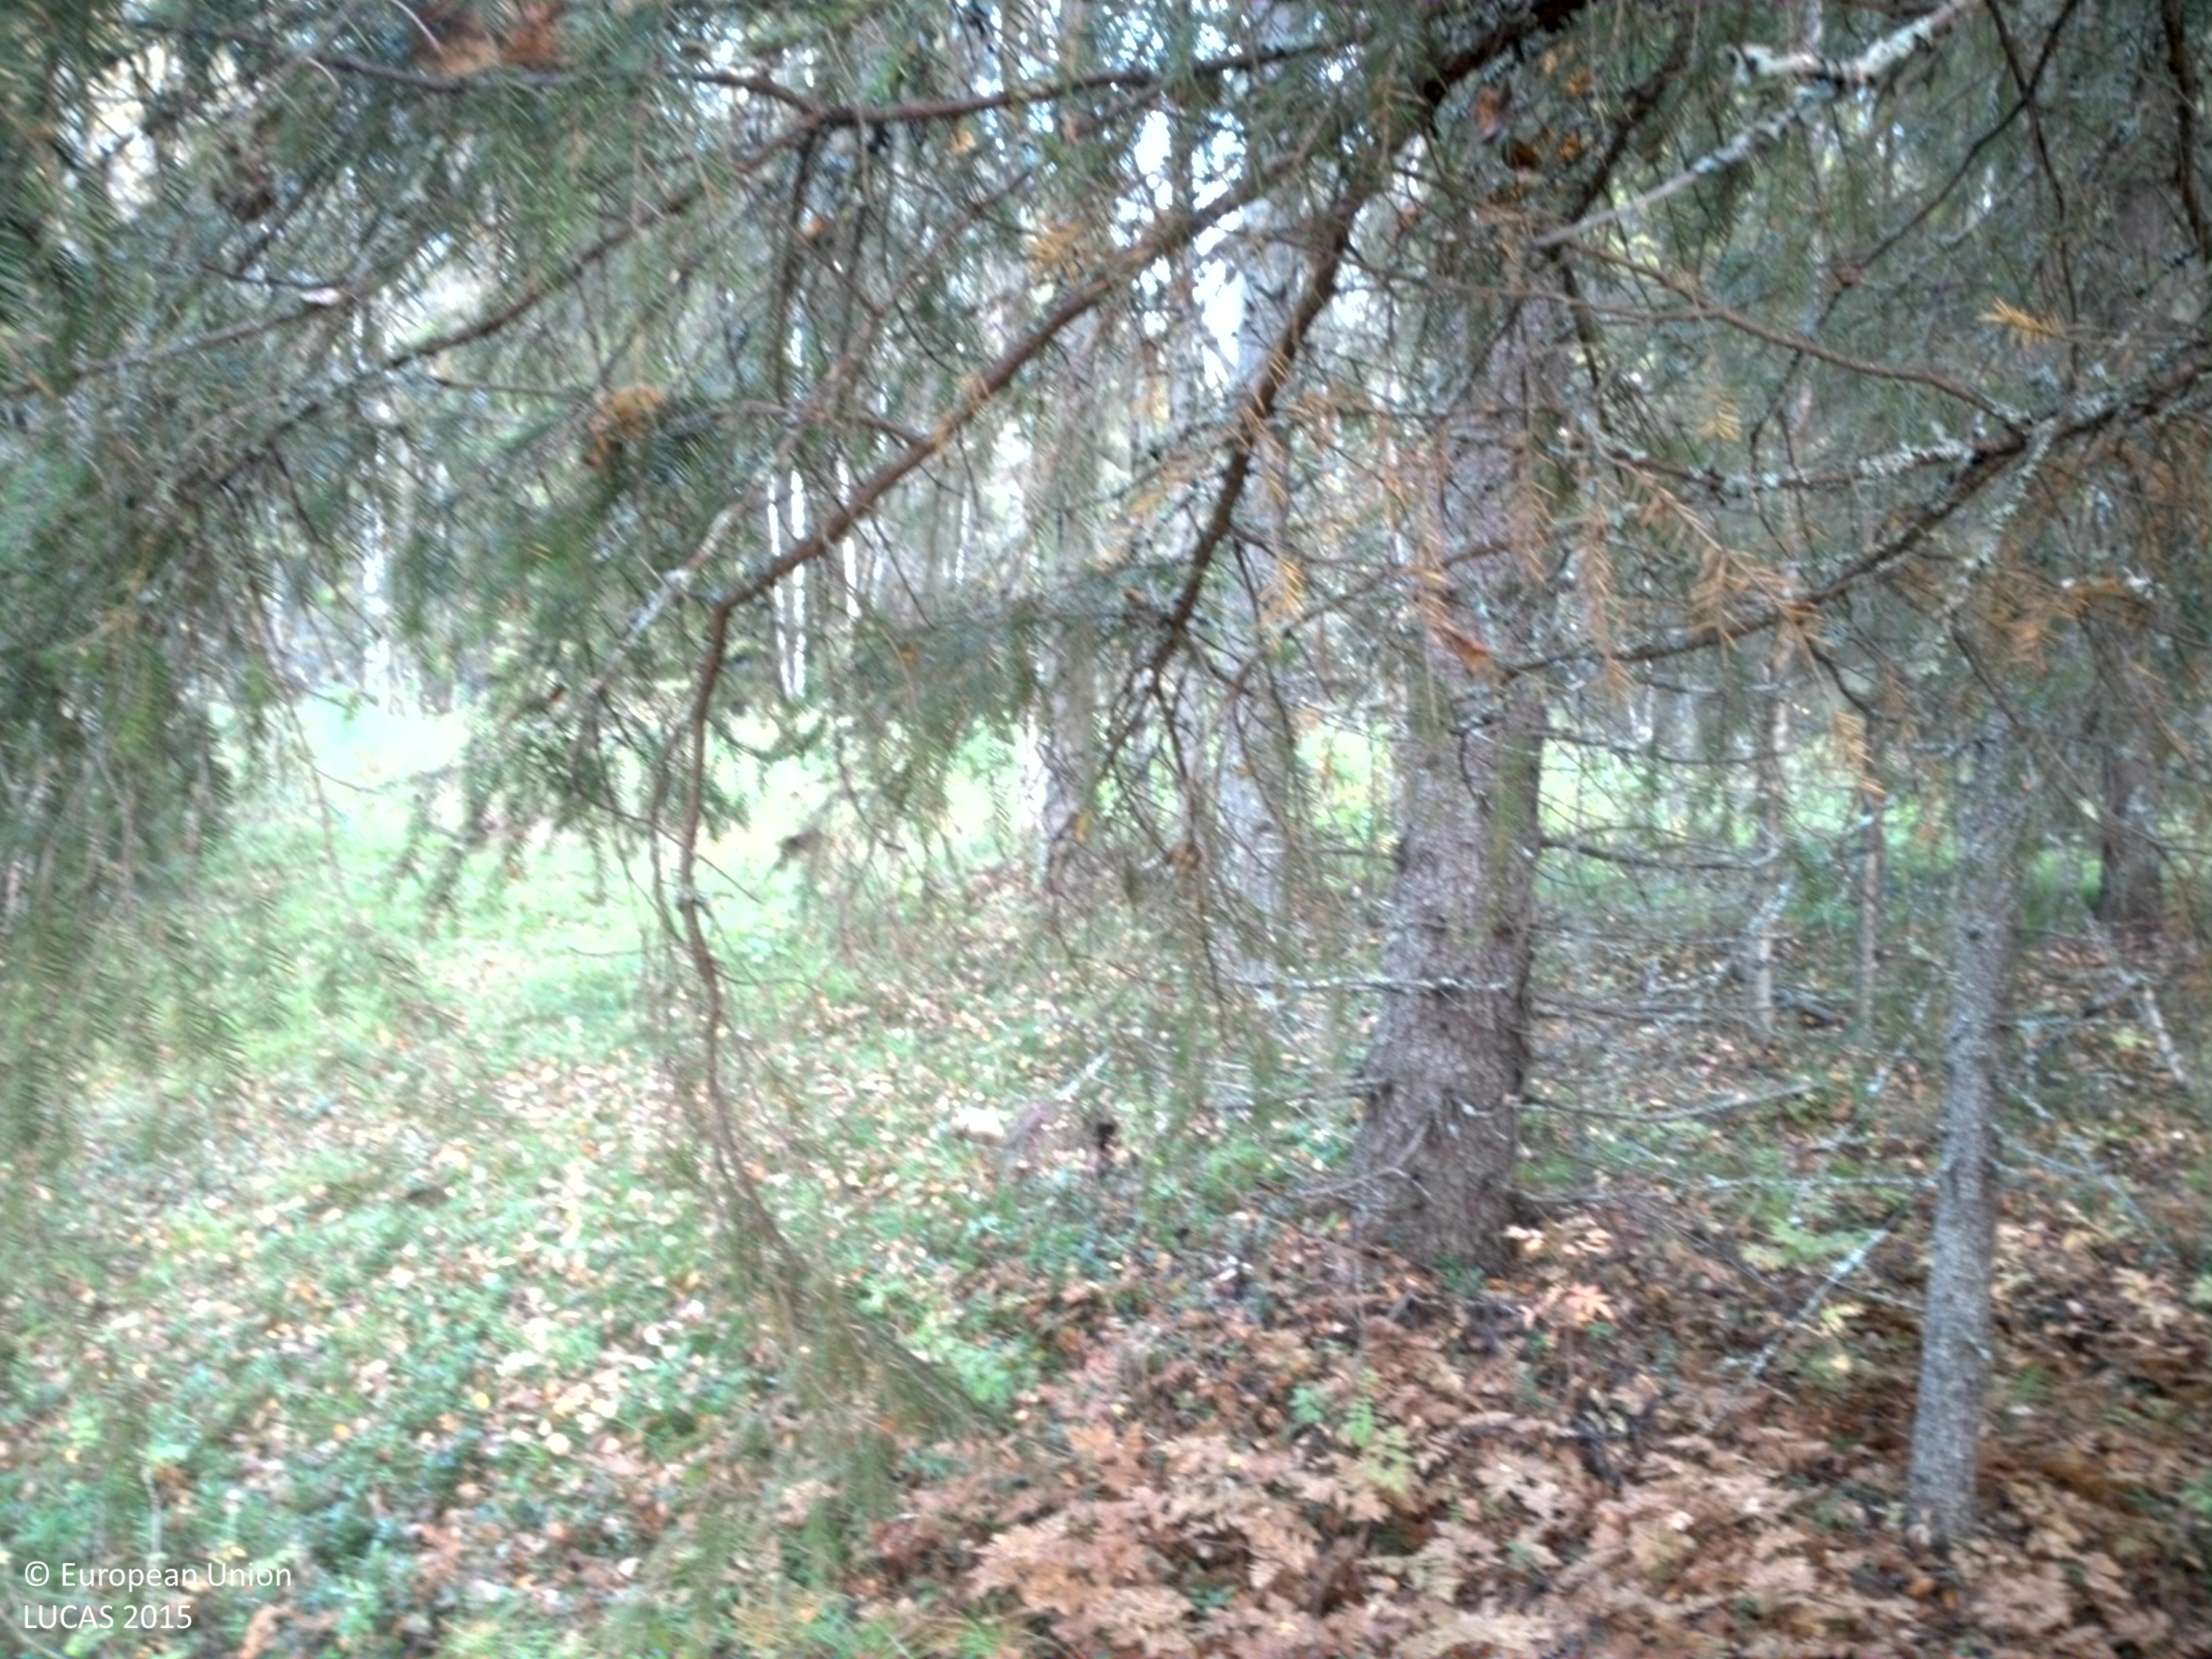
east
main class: Woodland
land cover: Spruce dominated mixed woodland
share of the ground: 50 - 75 %
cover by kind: coniferous forest trees 35 %, broadleaved forest trees 25 %, shrubs 20 %, herbaceous plants 15 %, unconsolidated bare surface 5 %
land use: Forestry
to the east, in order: Spruce dominated mixed woodland; Ditches and canals; Shrubland with sparse tree cover; Ditches and canals; Spruce dominated mixed woodland; Ditches and canals; Grassland with sparse tree/shrub cover; Spruce dominated mixed woodland; Grassland with sparse tree/shrub cover; Spruce dominated mixed woodland; Grassland with sparse tree/shrub cover; Spruce dominated coniferous woodland; Shrubland with sparse tree cover; Spruce dominated mixed woodland; Grassland with sparse tree/shrub cover
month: September
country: SE
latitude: 65.7281
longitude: 22.1210
